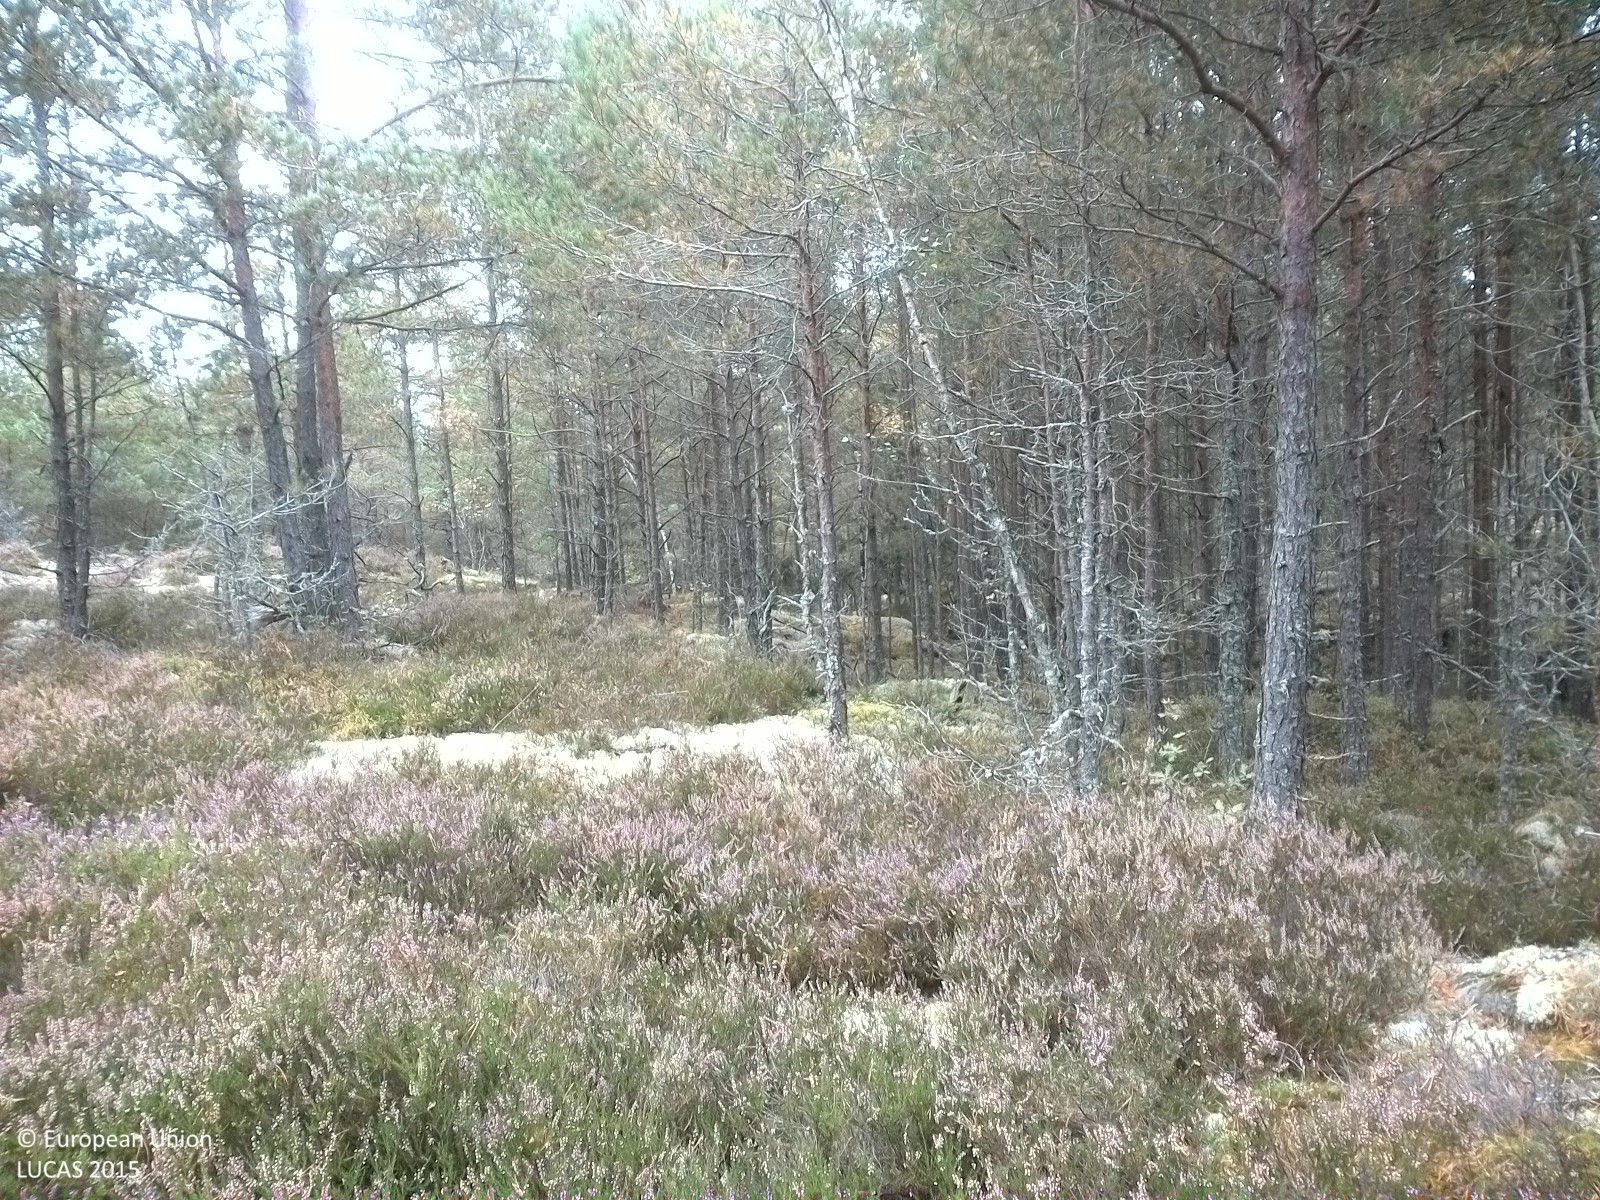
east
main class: Shrubland
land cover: Shrubland with sparse tree cover
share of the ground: > 75 %
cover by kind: shrubs 90 %, coniferous forest trees 5 %, lichens and mosses 5 %
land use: Semi-natural and natural areas not in use
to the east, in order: Shrubland with sparse tree cover; Pine dominated coniferous woodland; Pine dominated mixed woodland; Spruce dominated coniferous woodland
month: September
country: SE
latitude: 58.4678
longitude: 16.6999
